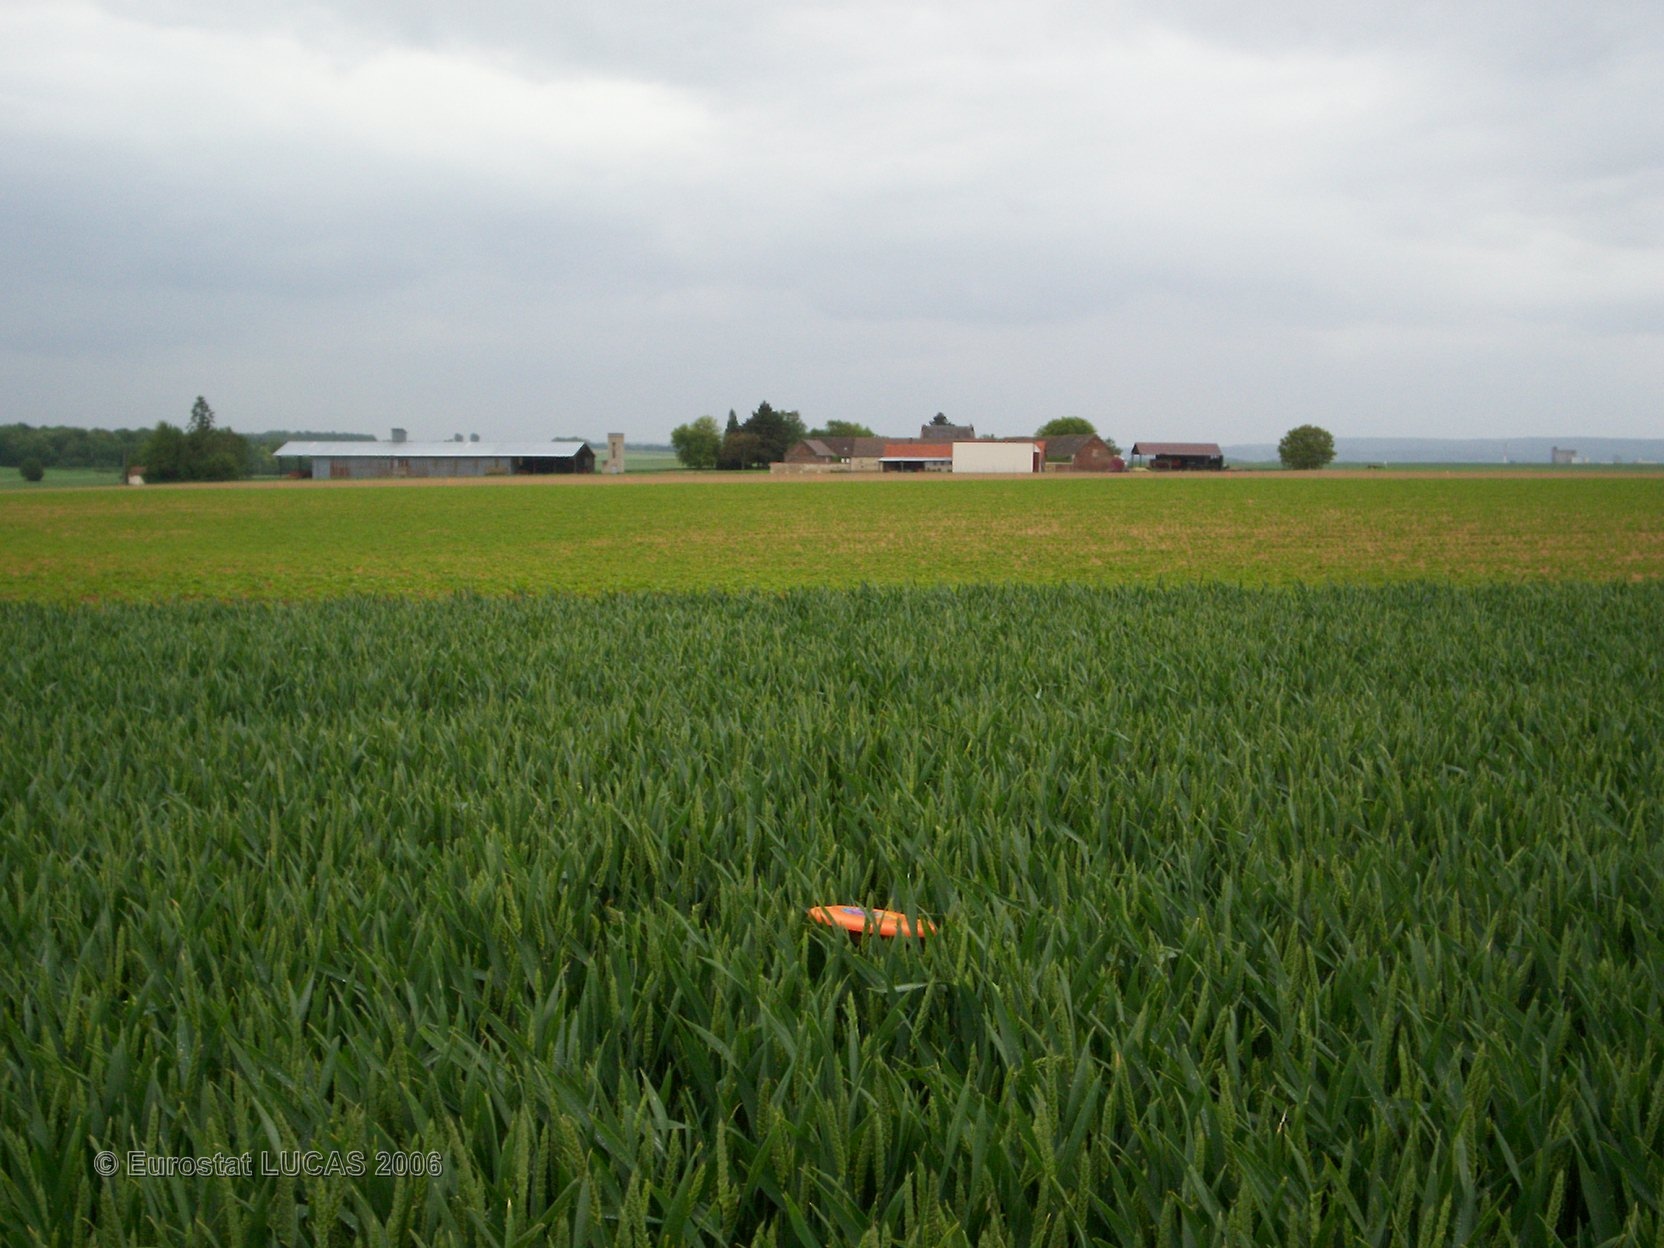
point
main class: Cropland
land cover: Common wheat
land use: Agriculture (excluding fallow land and kitchen gardens)
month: June
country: FR
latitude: 49.3886
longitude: 2.6736
